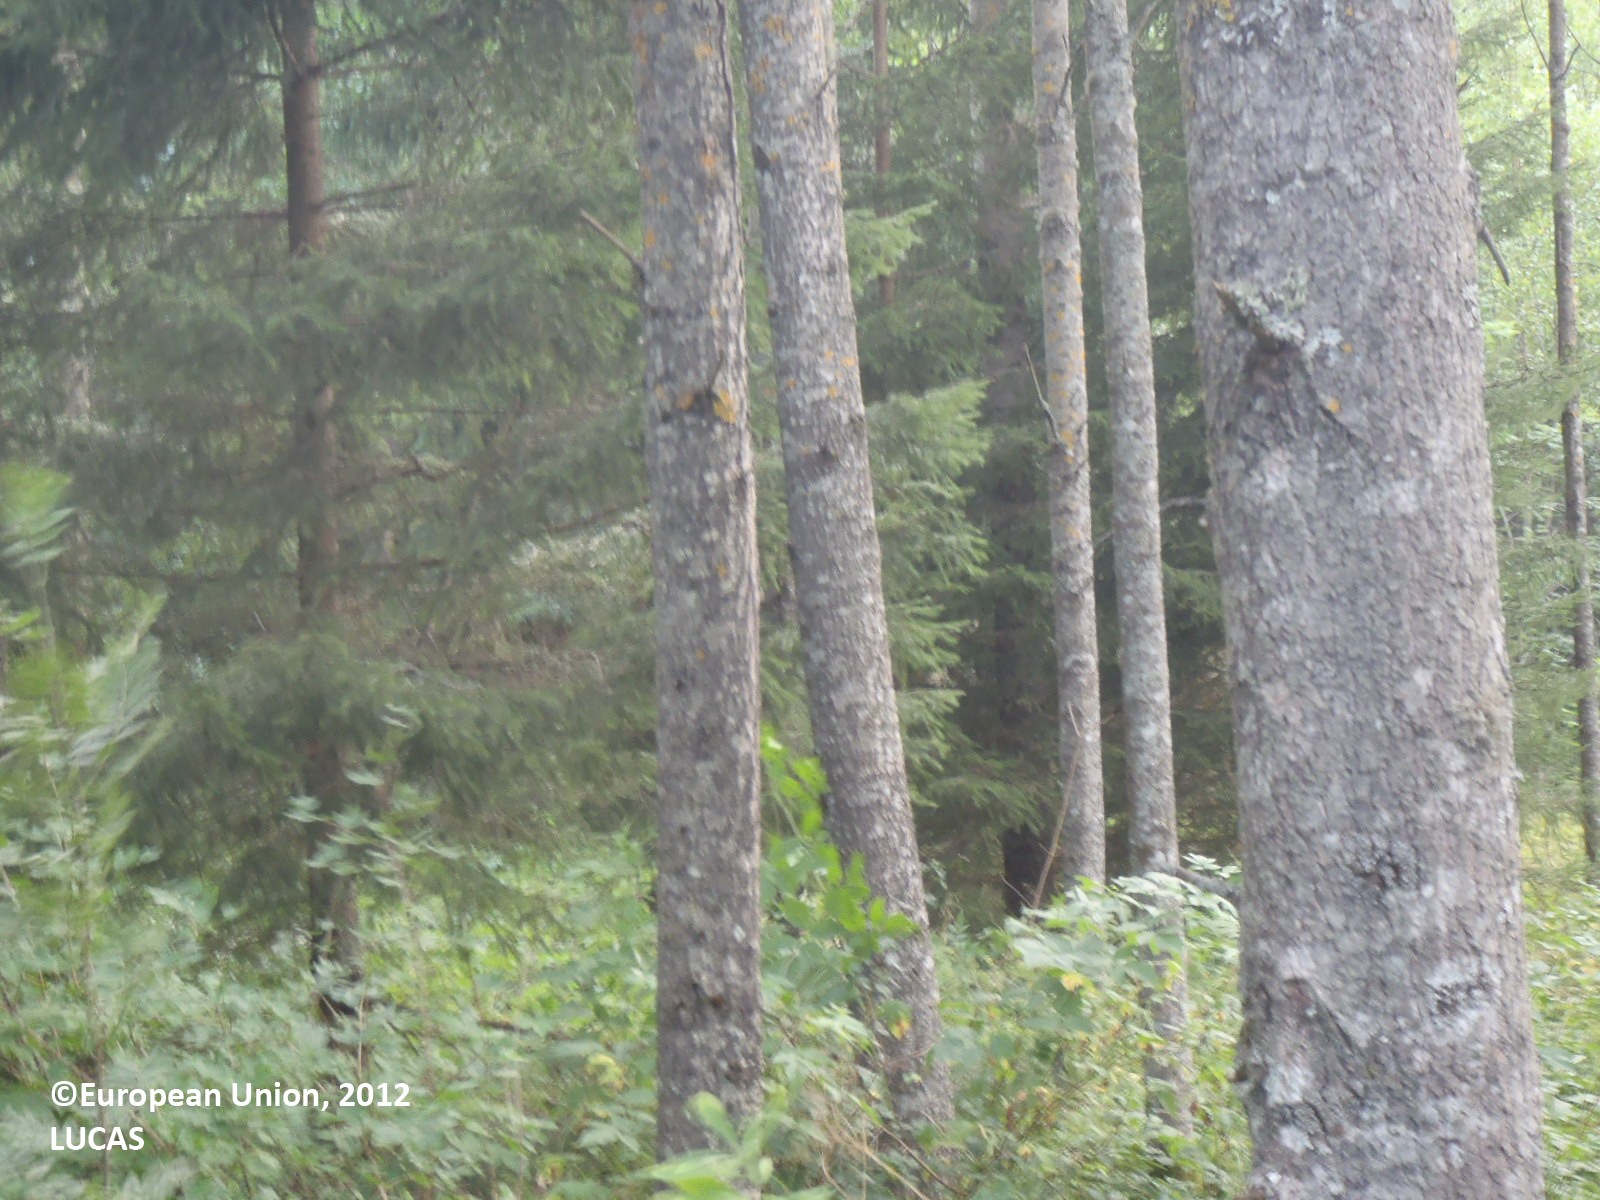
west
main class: Woodland
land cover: Broadleaved woodland
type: hemiboreal forest and nemoral coniferous forest and mixed broadleaved-coniferous forest
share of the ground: > 75 %
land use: Semi-natural and natural areas not in use
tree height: > 5 m
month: August
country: FI
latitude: 60.2809
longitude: 19.9702
